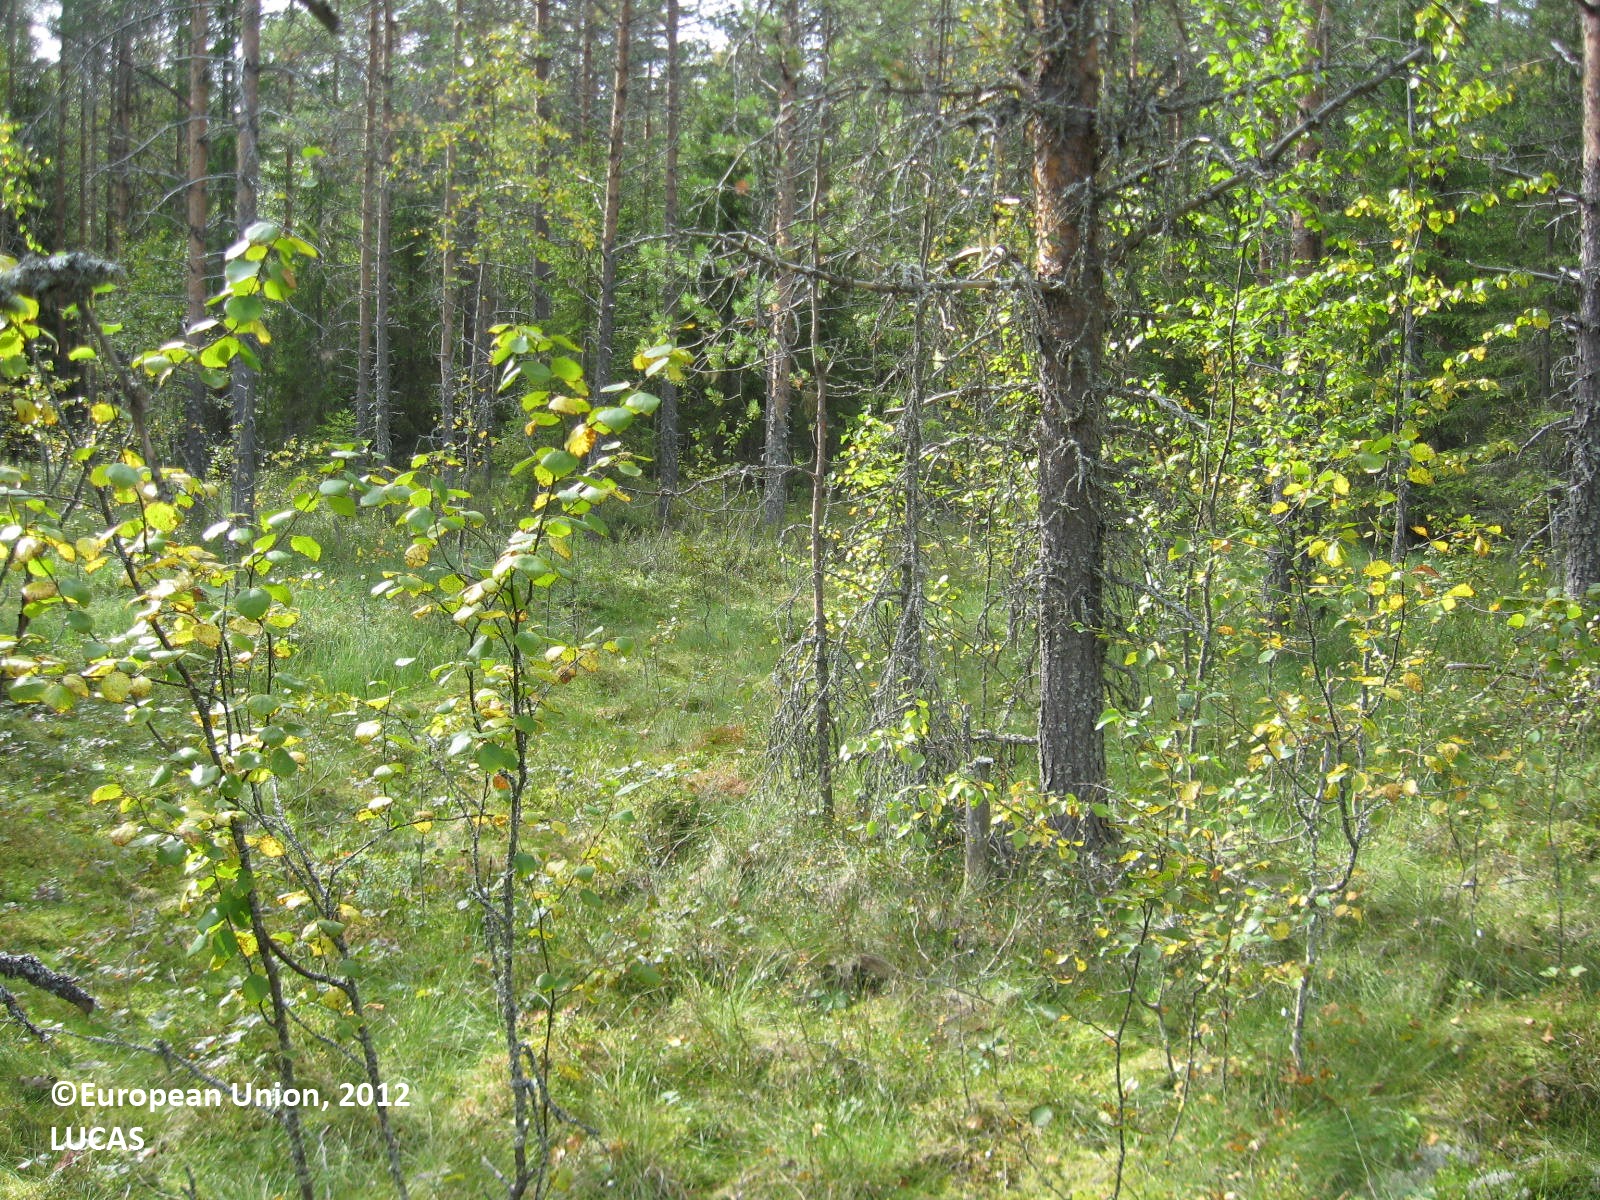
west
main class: Woodland
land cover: Pine dominated mixed woodland
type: boreal forest
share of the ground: 50 - 75 %
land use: Forestry
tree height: > 5 m
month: August
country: FI
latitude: 63.8425
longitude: 29.0525
